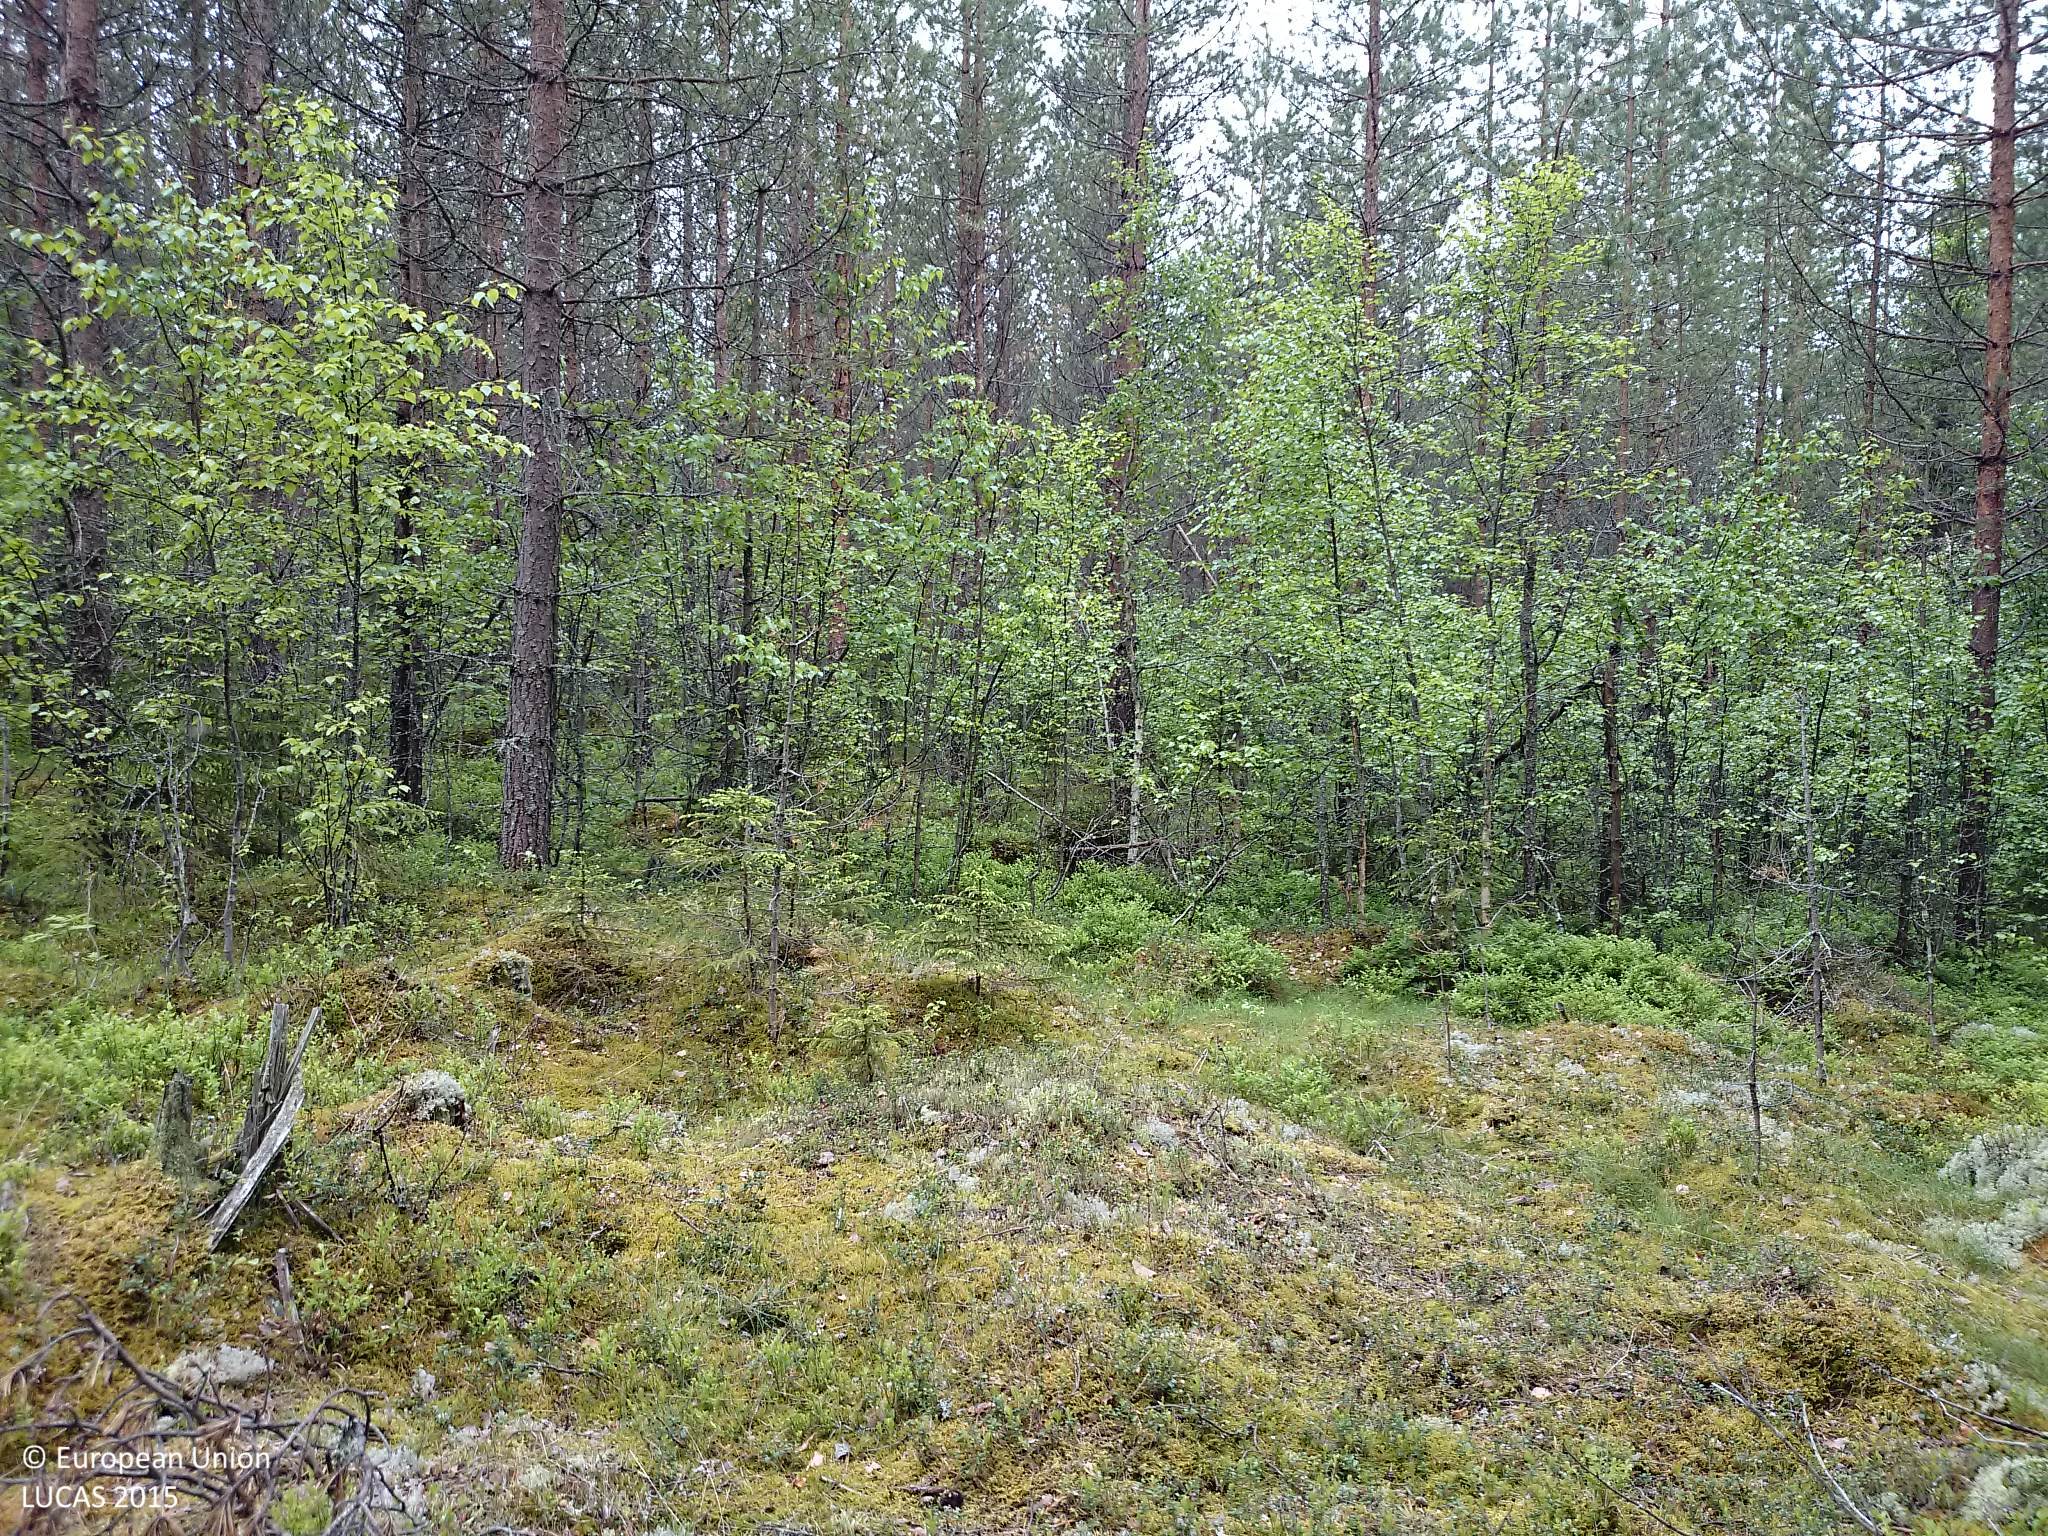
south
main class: Woodland
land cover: Pine dominated mixed woodland
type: boreal forest
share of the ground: > 75 %
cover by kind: coniferous forest trees 60 %, broadleaved forest trees 20 %, shrubs 20 %
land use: Forestry
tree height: > 5 m
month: June
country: SE
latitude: 64.1253
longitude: 20.7237
